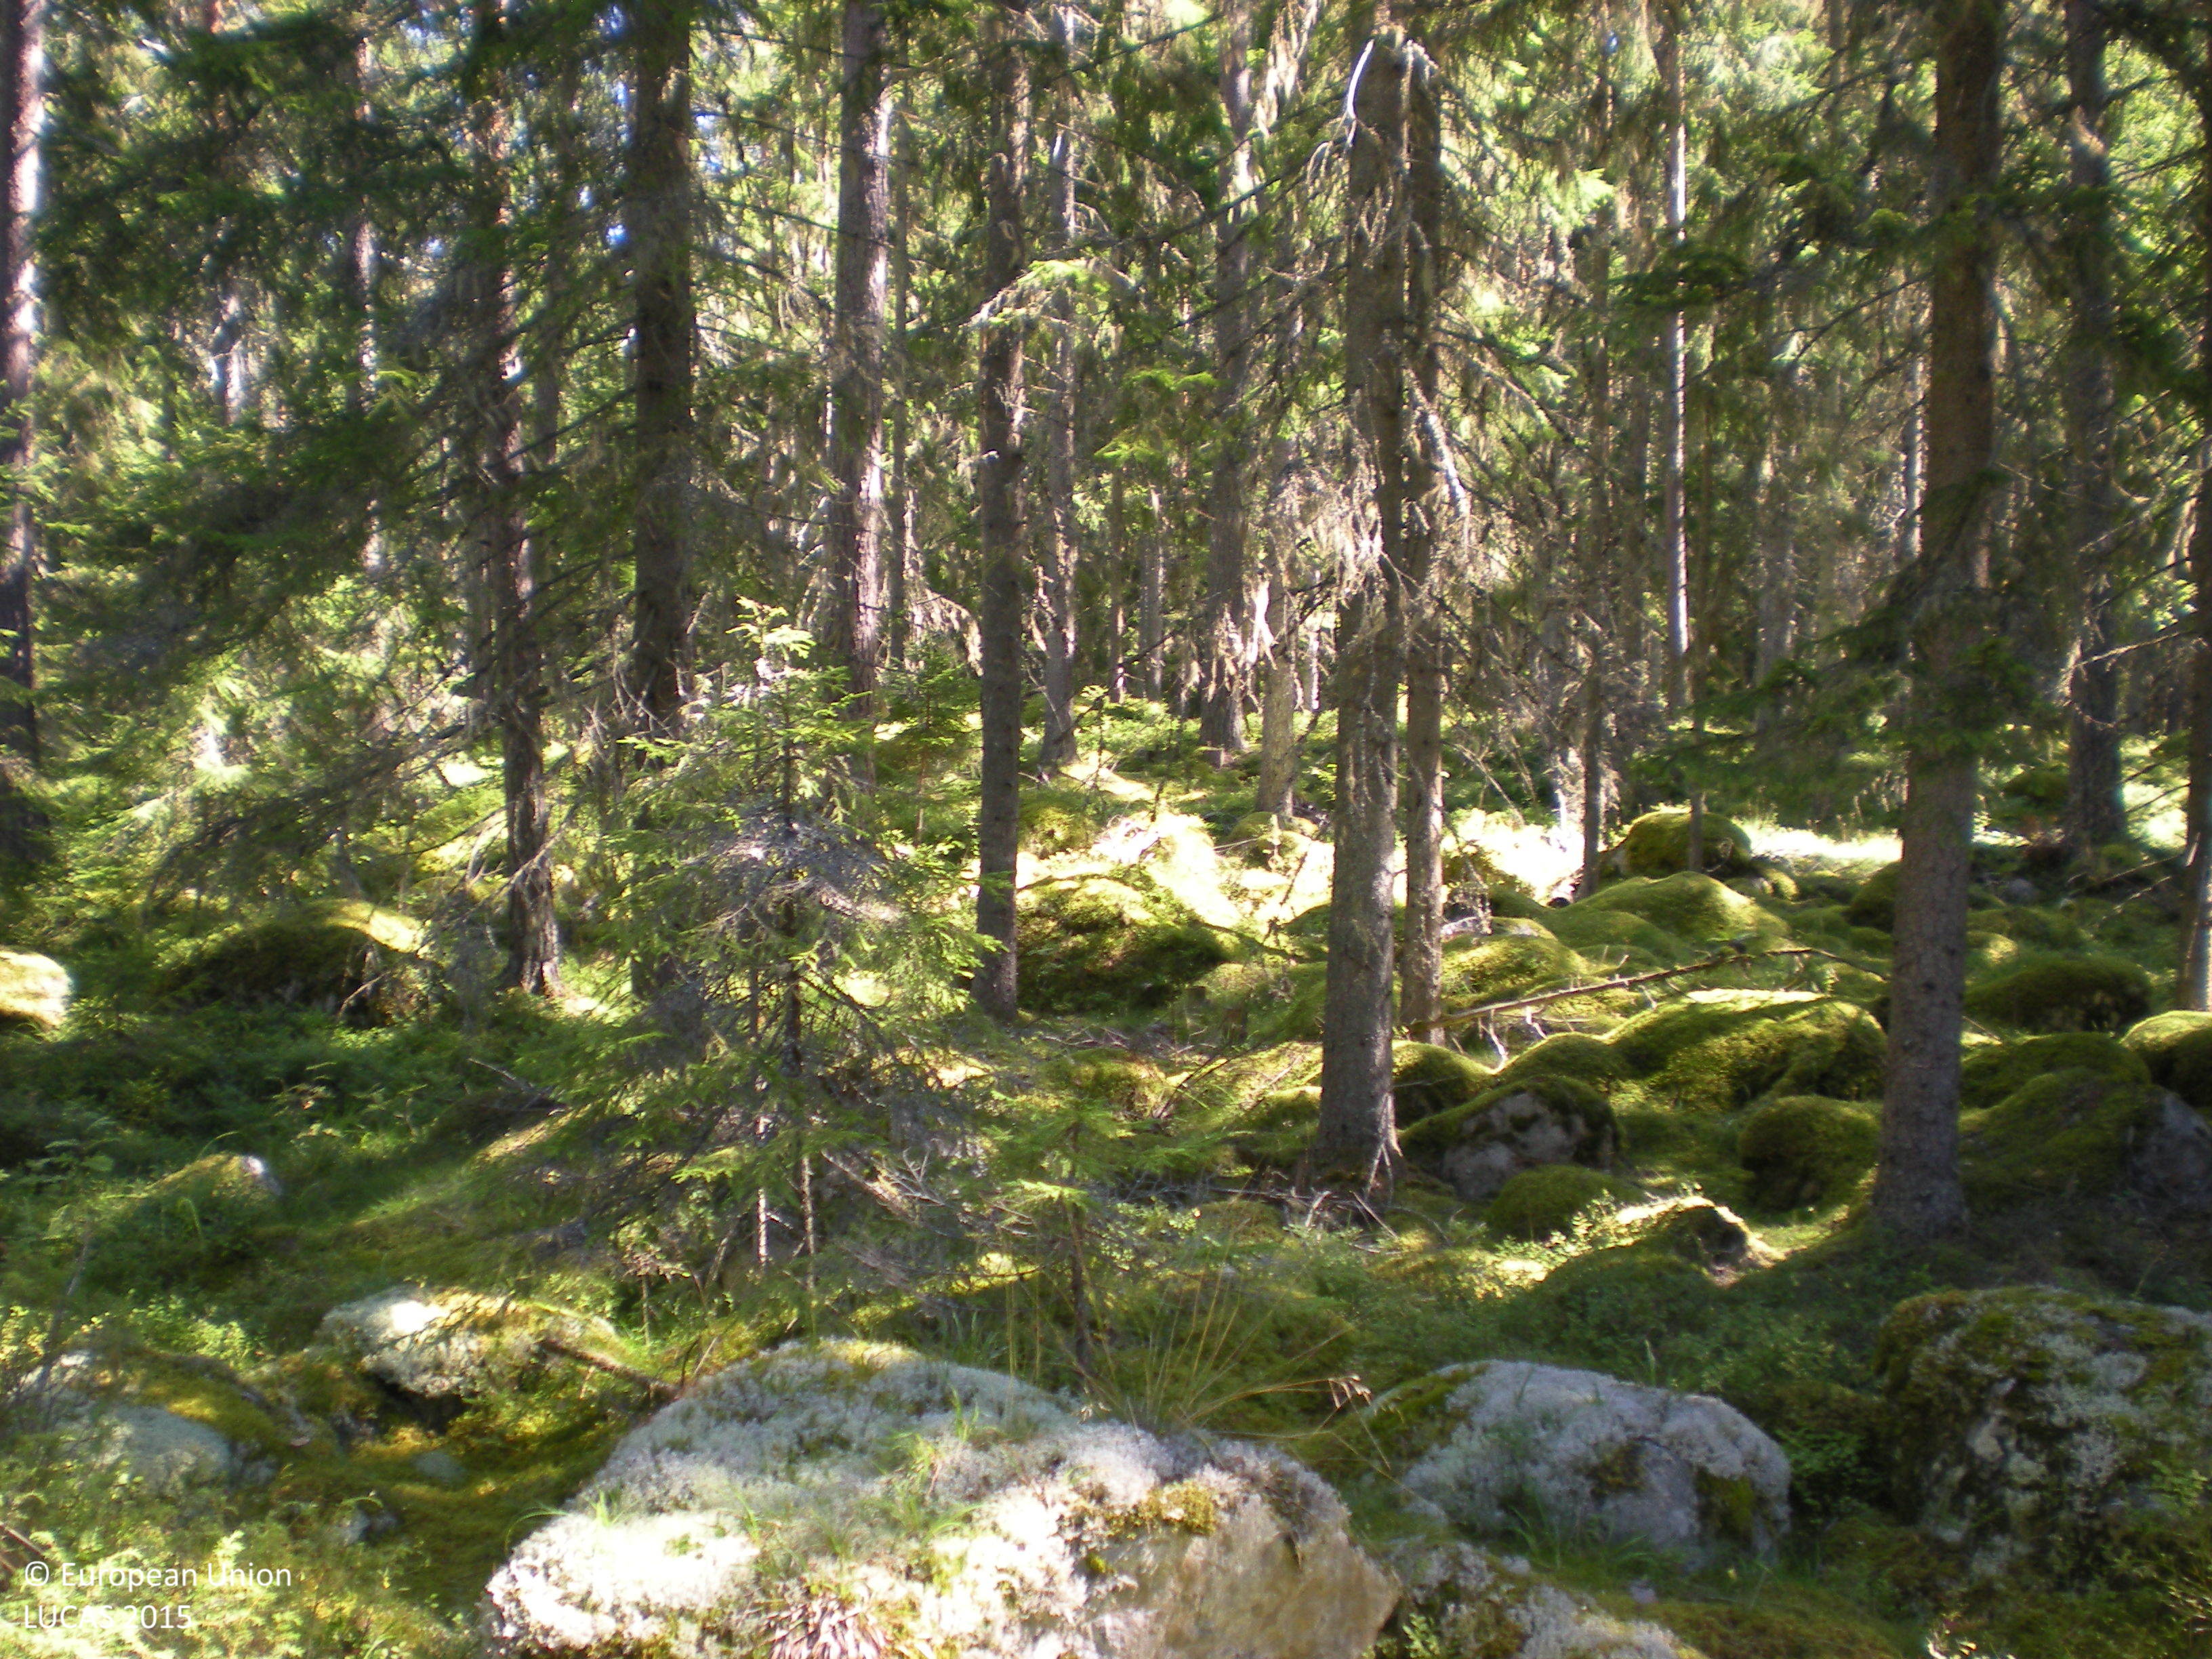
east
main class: Woodland
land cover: Spruce dominated coniferous woodland
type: boreal forest
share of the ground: 50 - 75 %
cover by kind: coniferous forest trees 65 %, shrubs 20 %, herbaceous plants 10 %, lichens and mosses 5 %
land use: Forestry
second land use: Amenities, museums, leisure
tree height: > 5 m
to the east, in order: Spruce dominated coniferous woodland; Shrubland with sparse tree cover; Spruce dominated coniferous woodland; Other coniferous woodland
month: August
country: SE
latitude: 60.7064
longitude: 17.1161
